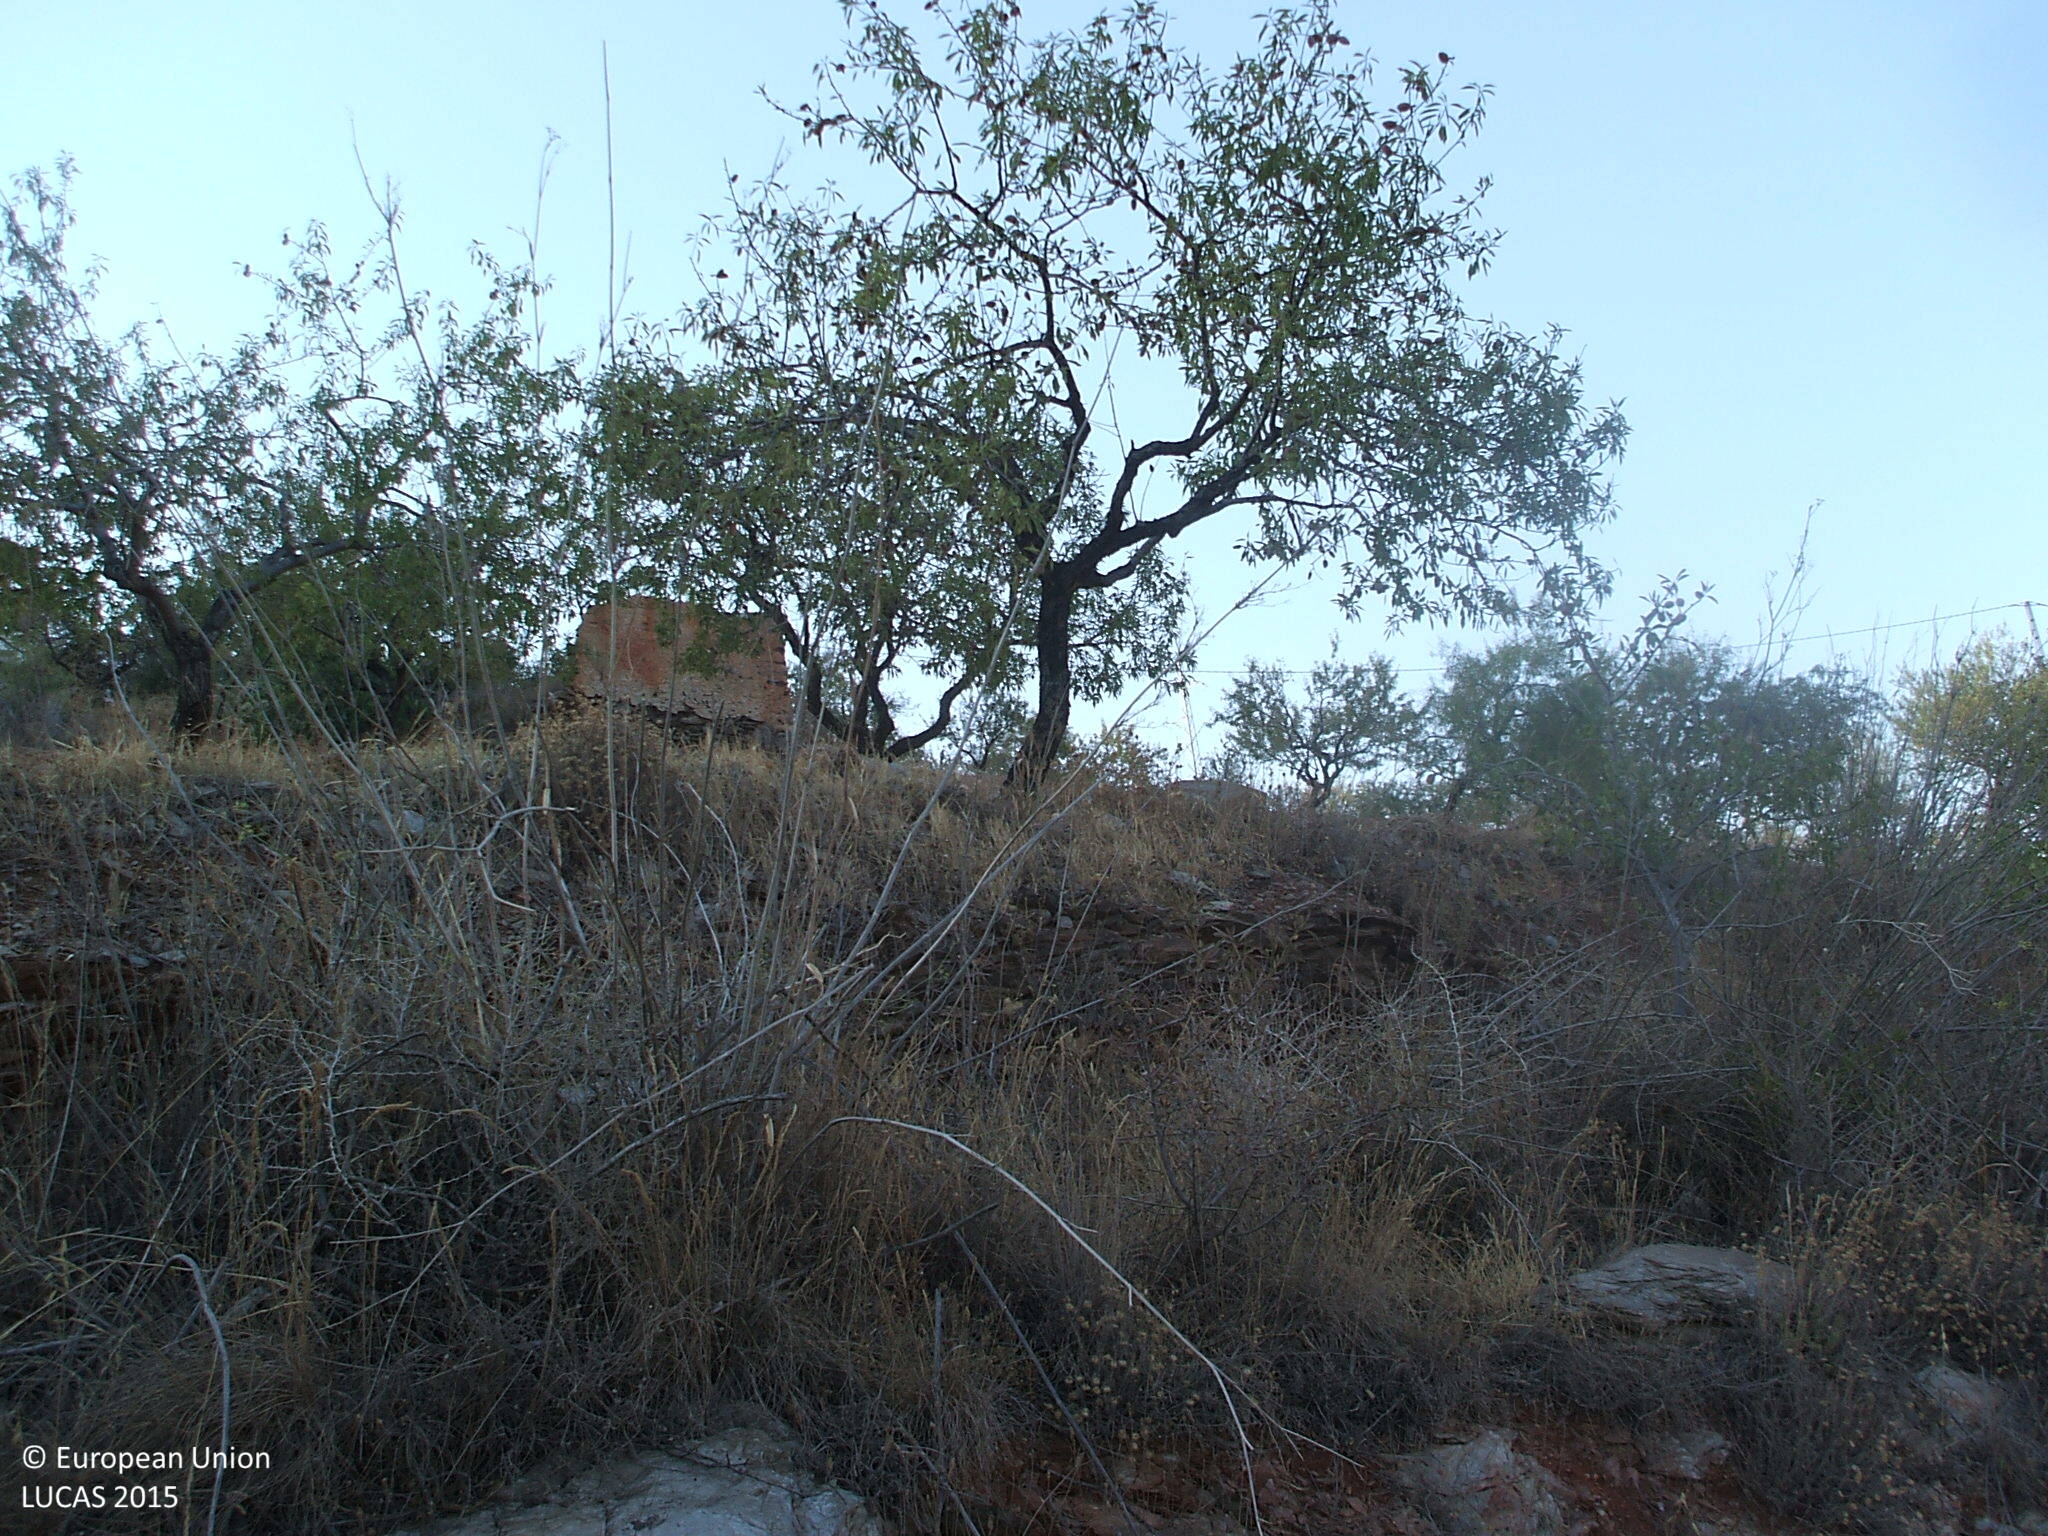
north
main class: Cropland
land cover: Nuts trees
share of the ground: 10 - 25 %
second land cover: Other bare soil
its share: > 75 %
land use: Agriculture (excluding fallow land and kitchen gardens)
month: July
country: ES
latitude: 36.7851
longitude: -3.0778
